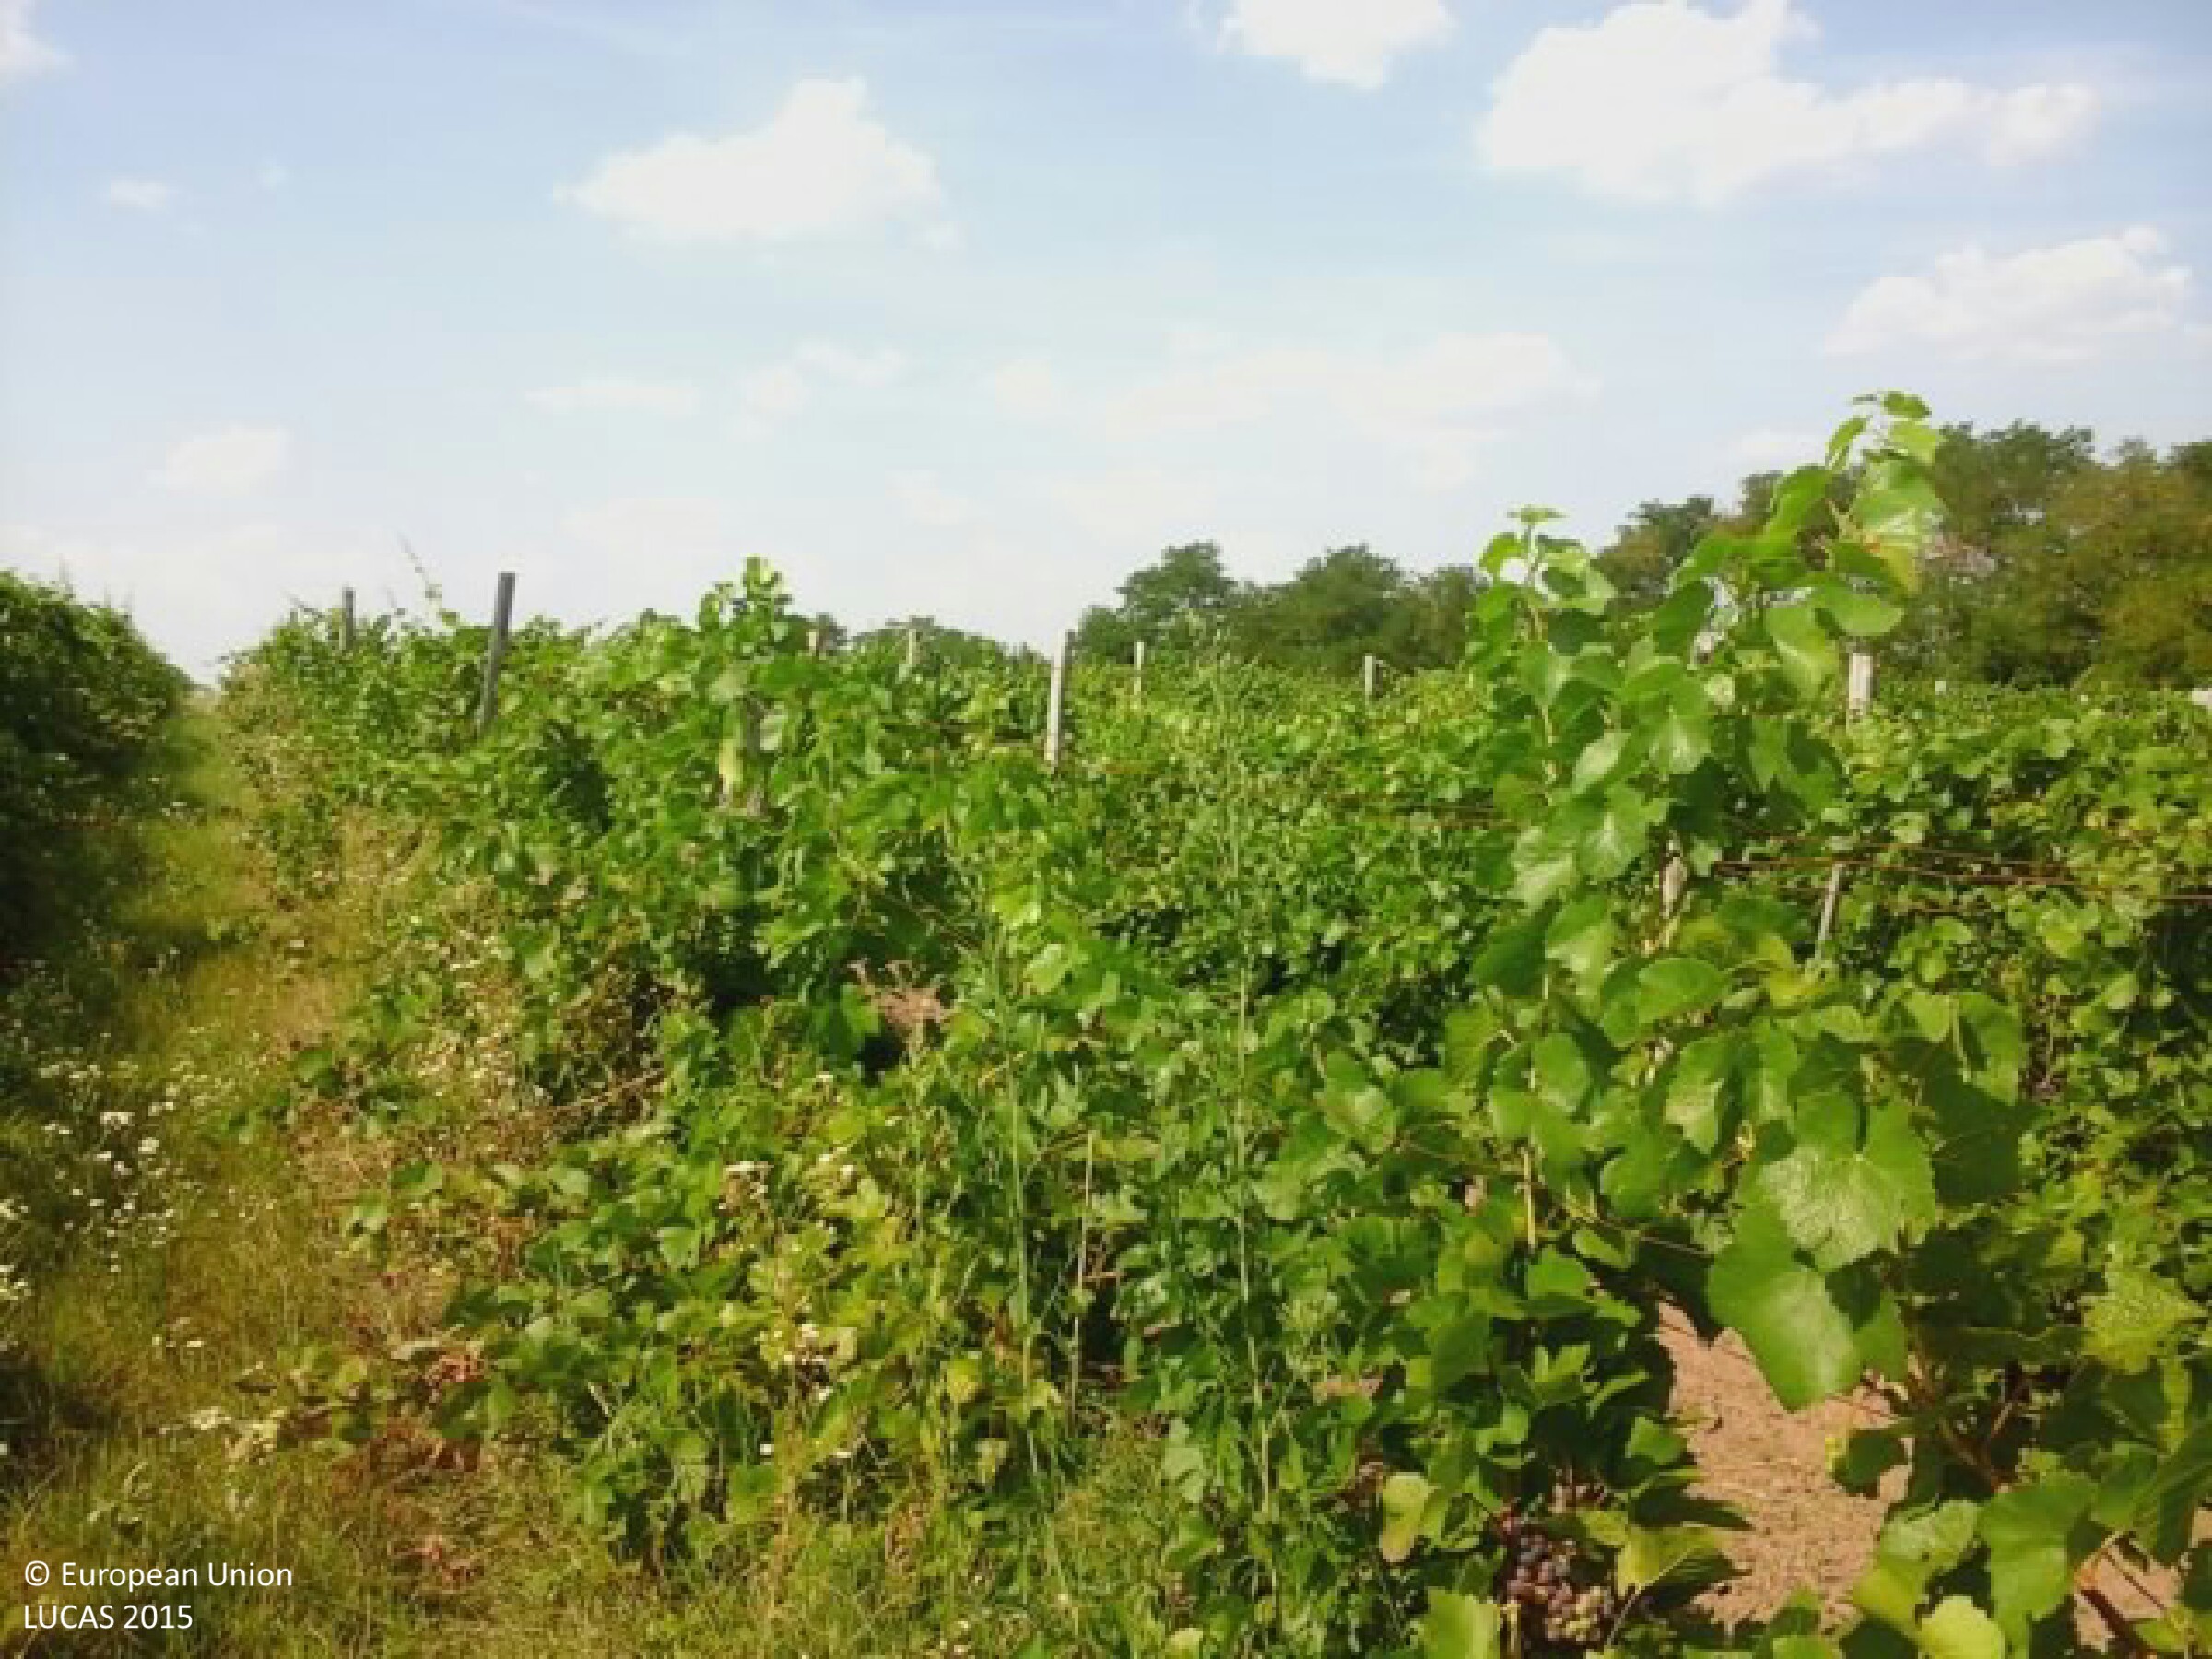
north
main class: Cropland
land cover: Vineyards
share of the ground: 50 - 75 %
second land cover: Grassland without tree/shrub cover
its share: 50 - 75 %
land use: Agriculture (excluding fallow land and kitchen gardens)
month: August
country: HU
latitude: 46.7724
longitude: 18.2733
